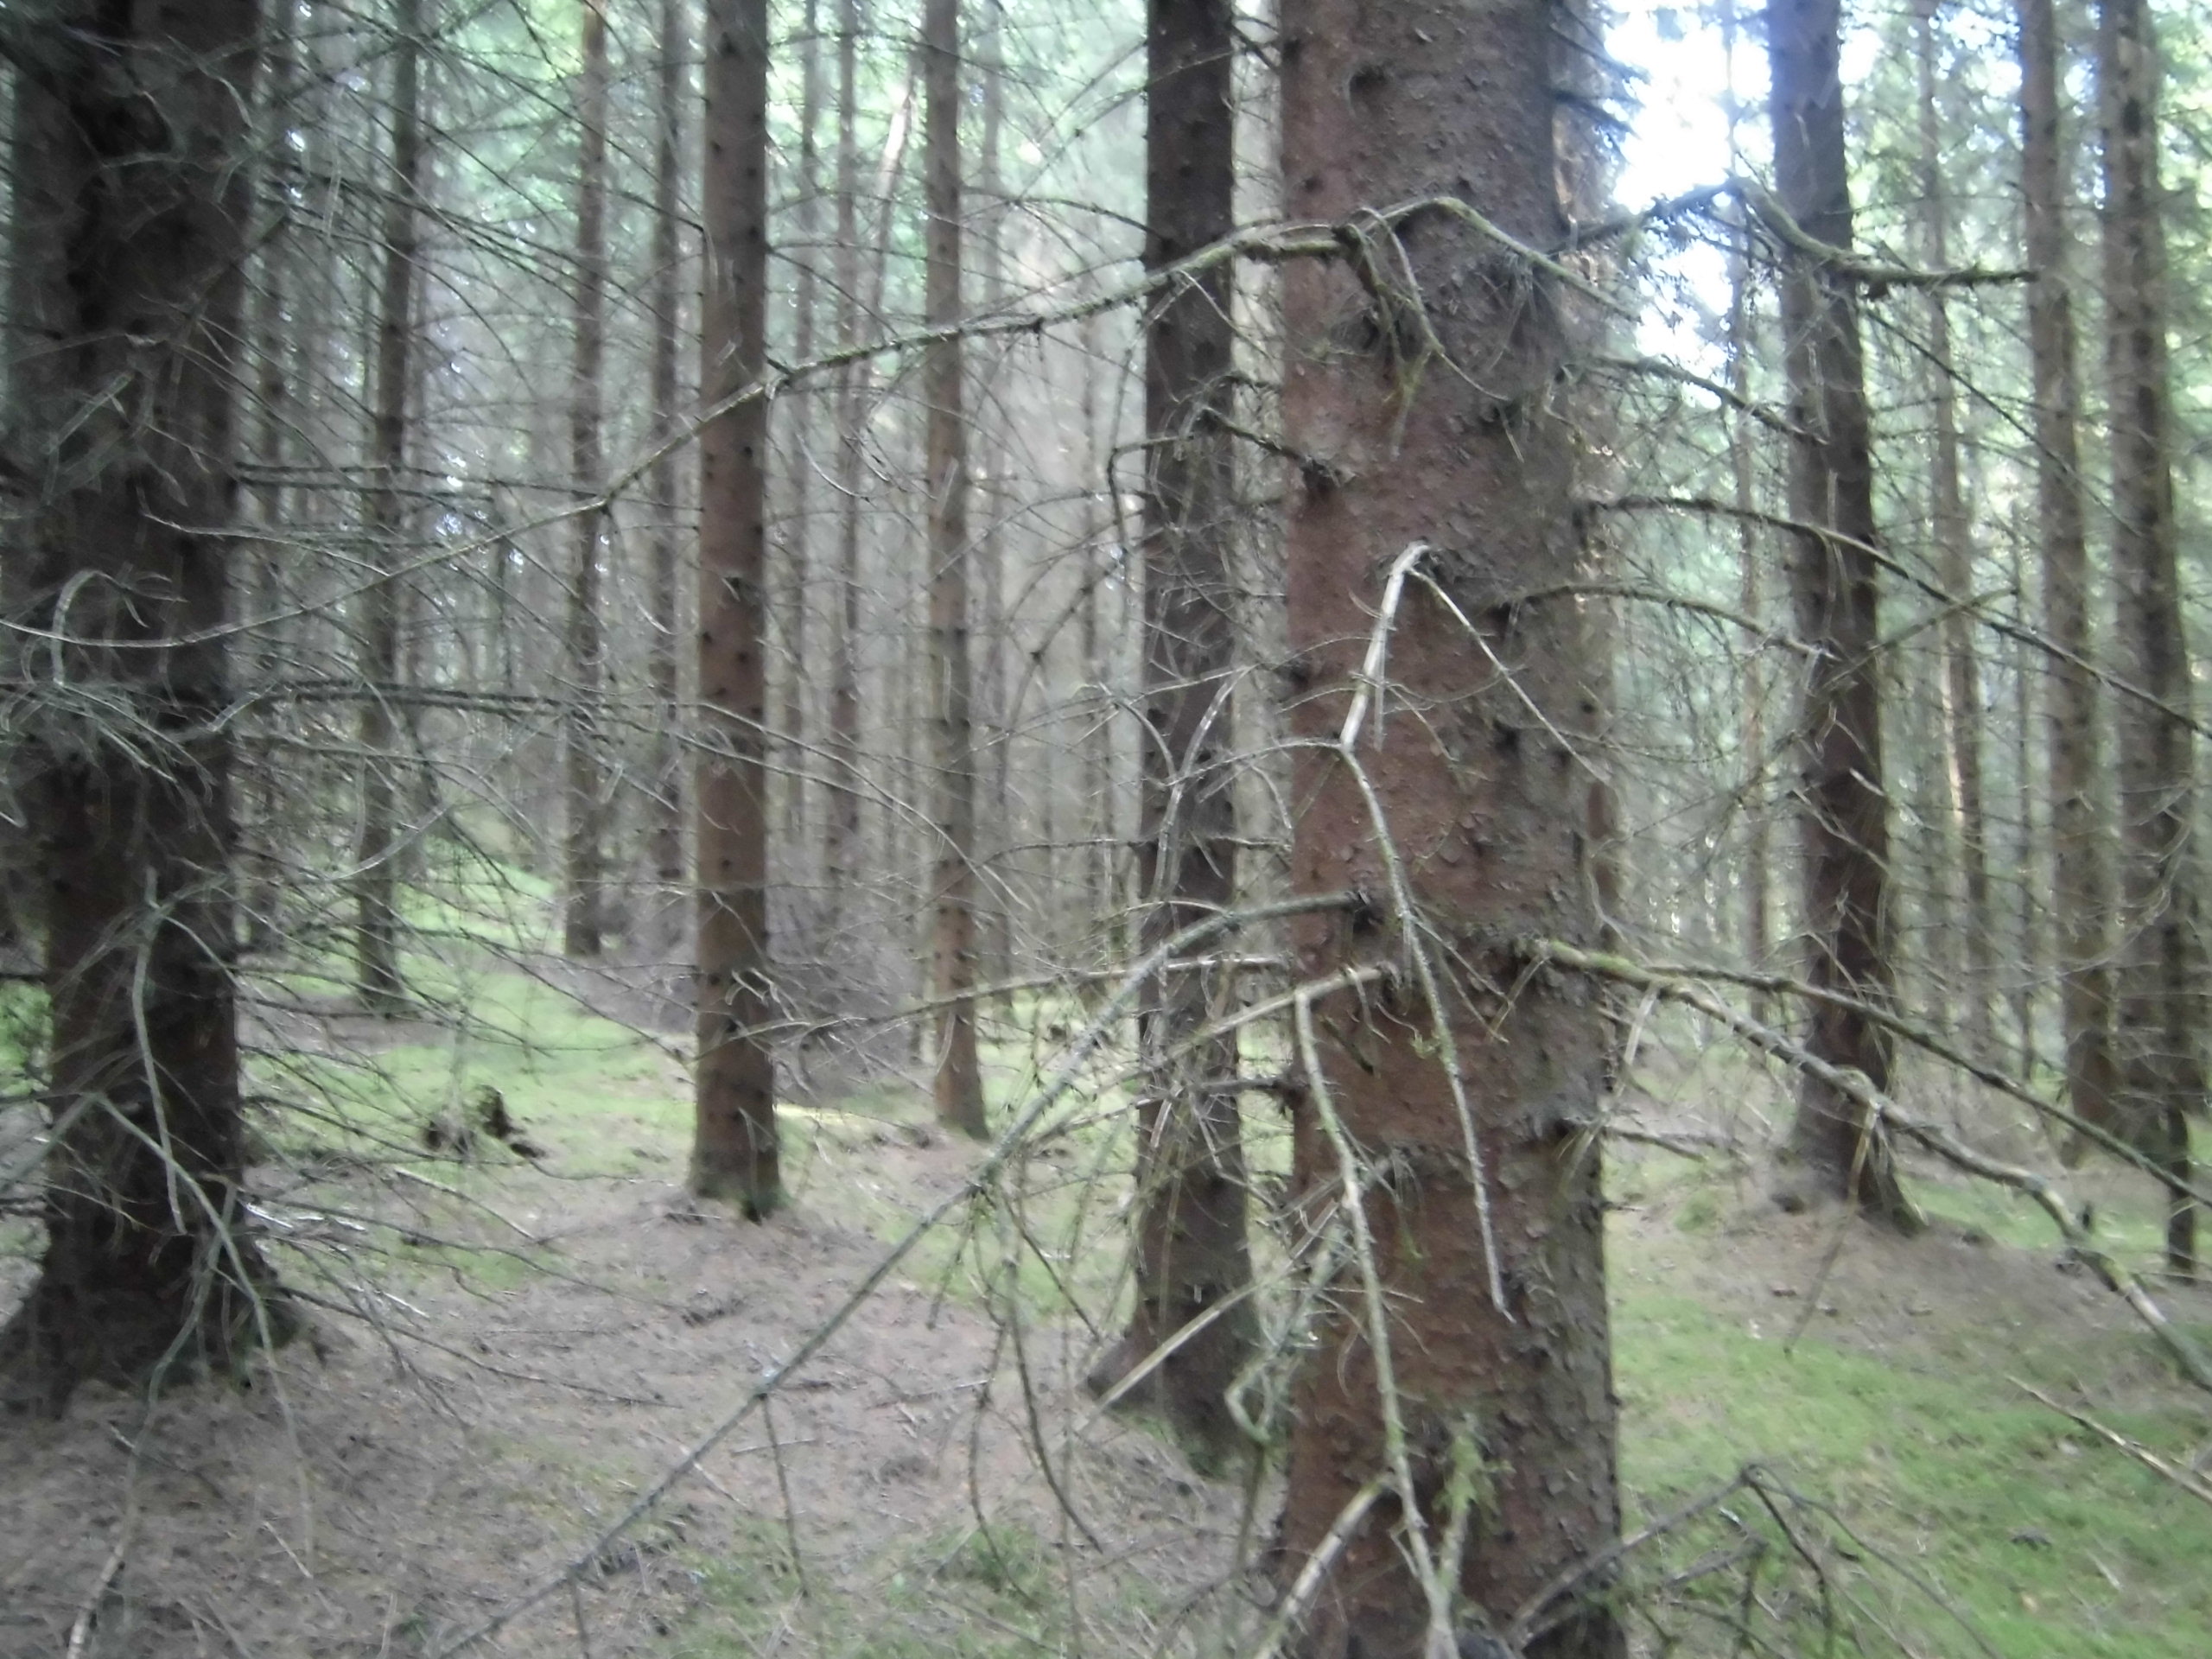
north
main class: Woodland
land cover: Spruce dominated coniferous woodland
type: boreal forest
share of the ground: 50 - 75 %
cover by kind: coniferous forest trees 70 %, lichens and mosses 25 %, herbaceous plants 5 %
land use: Forestry
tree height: > 5 m
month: July
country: SE
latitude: 57.1711
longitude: 14.5114
